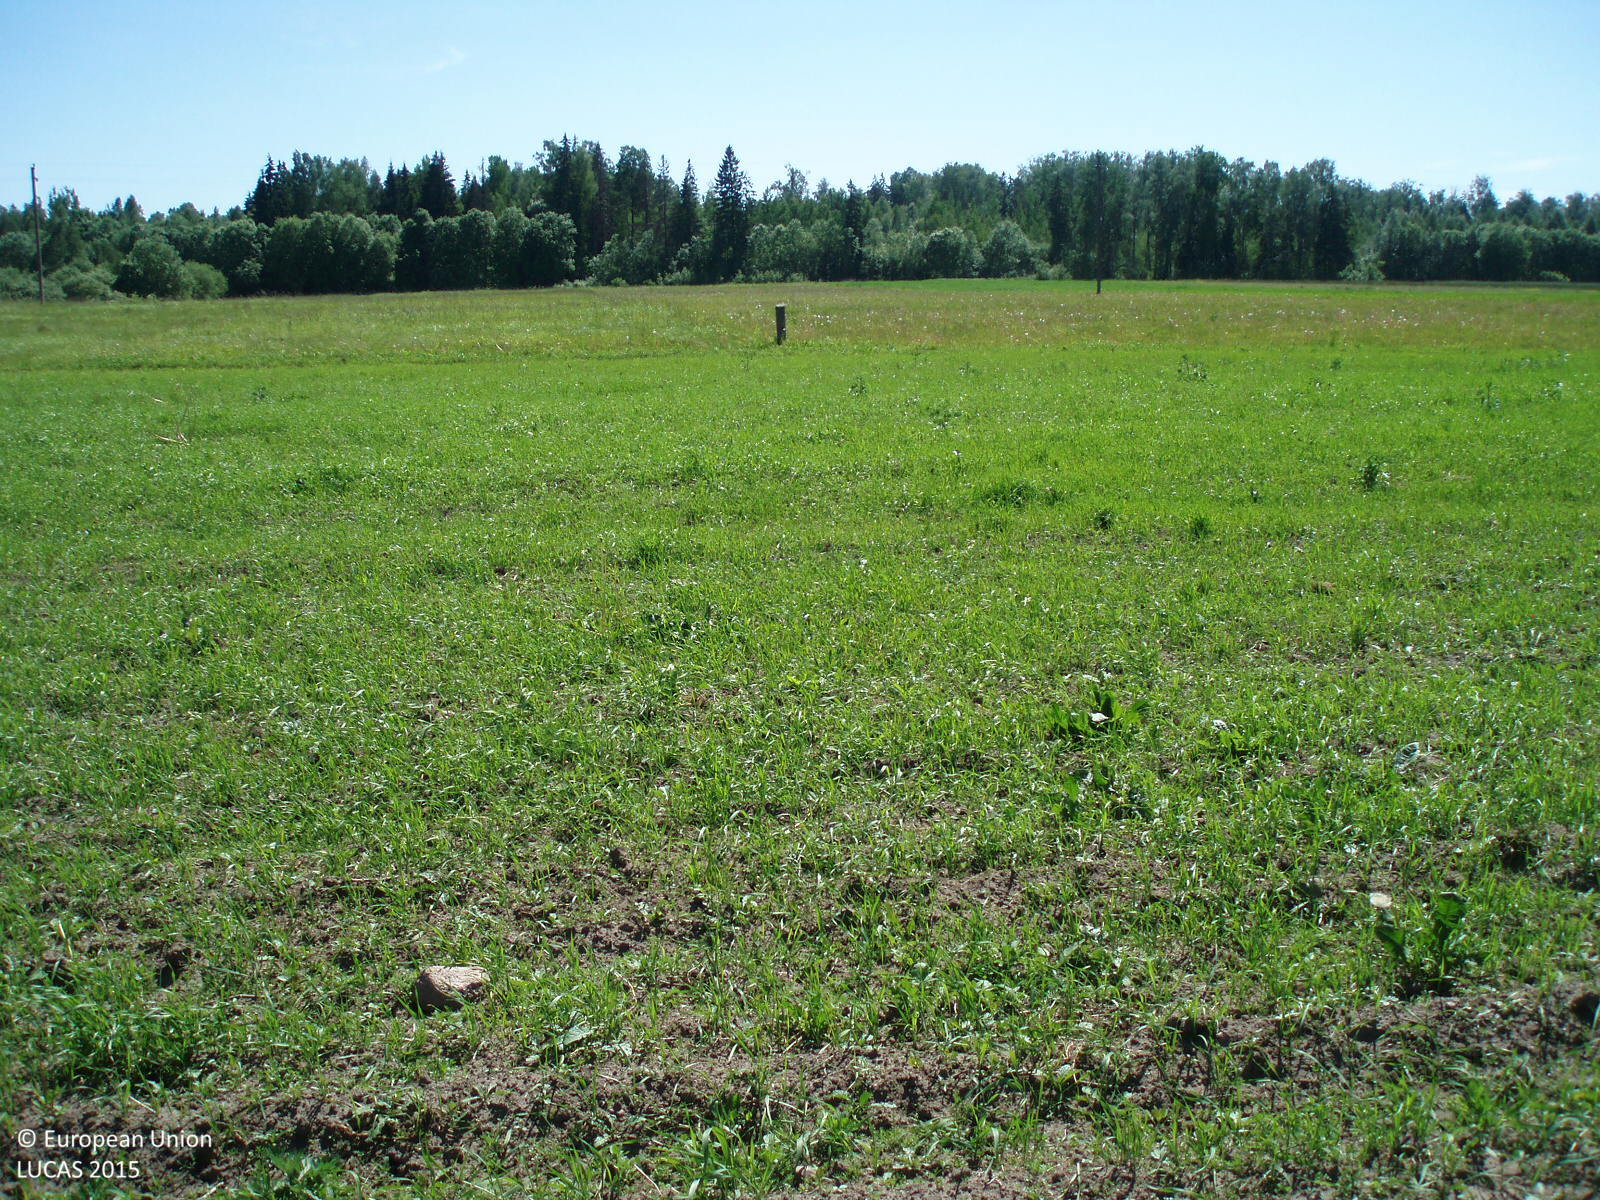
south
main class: Cropland
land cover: Rye
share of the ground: > 75 %
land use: Agriculture (excluding fallow land and kitchen gardens)
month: June
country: LT
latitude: 56.2206
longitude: 22.5904
